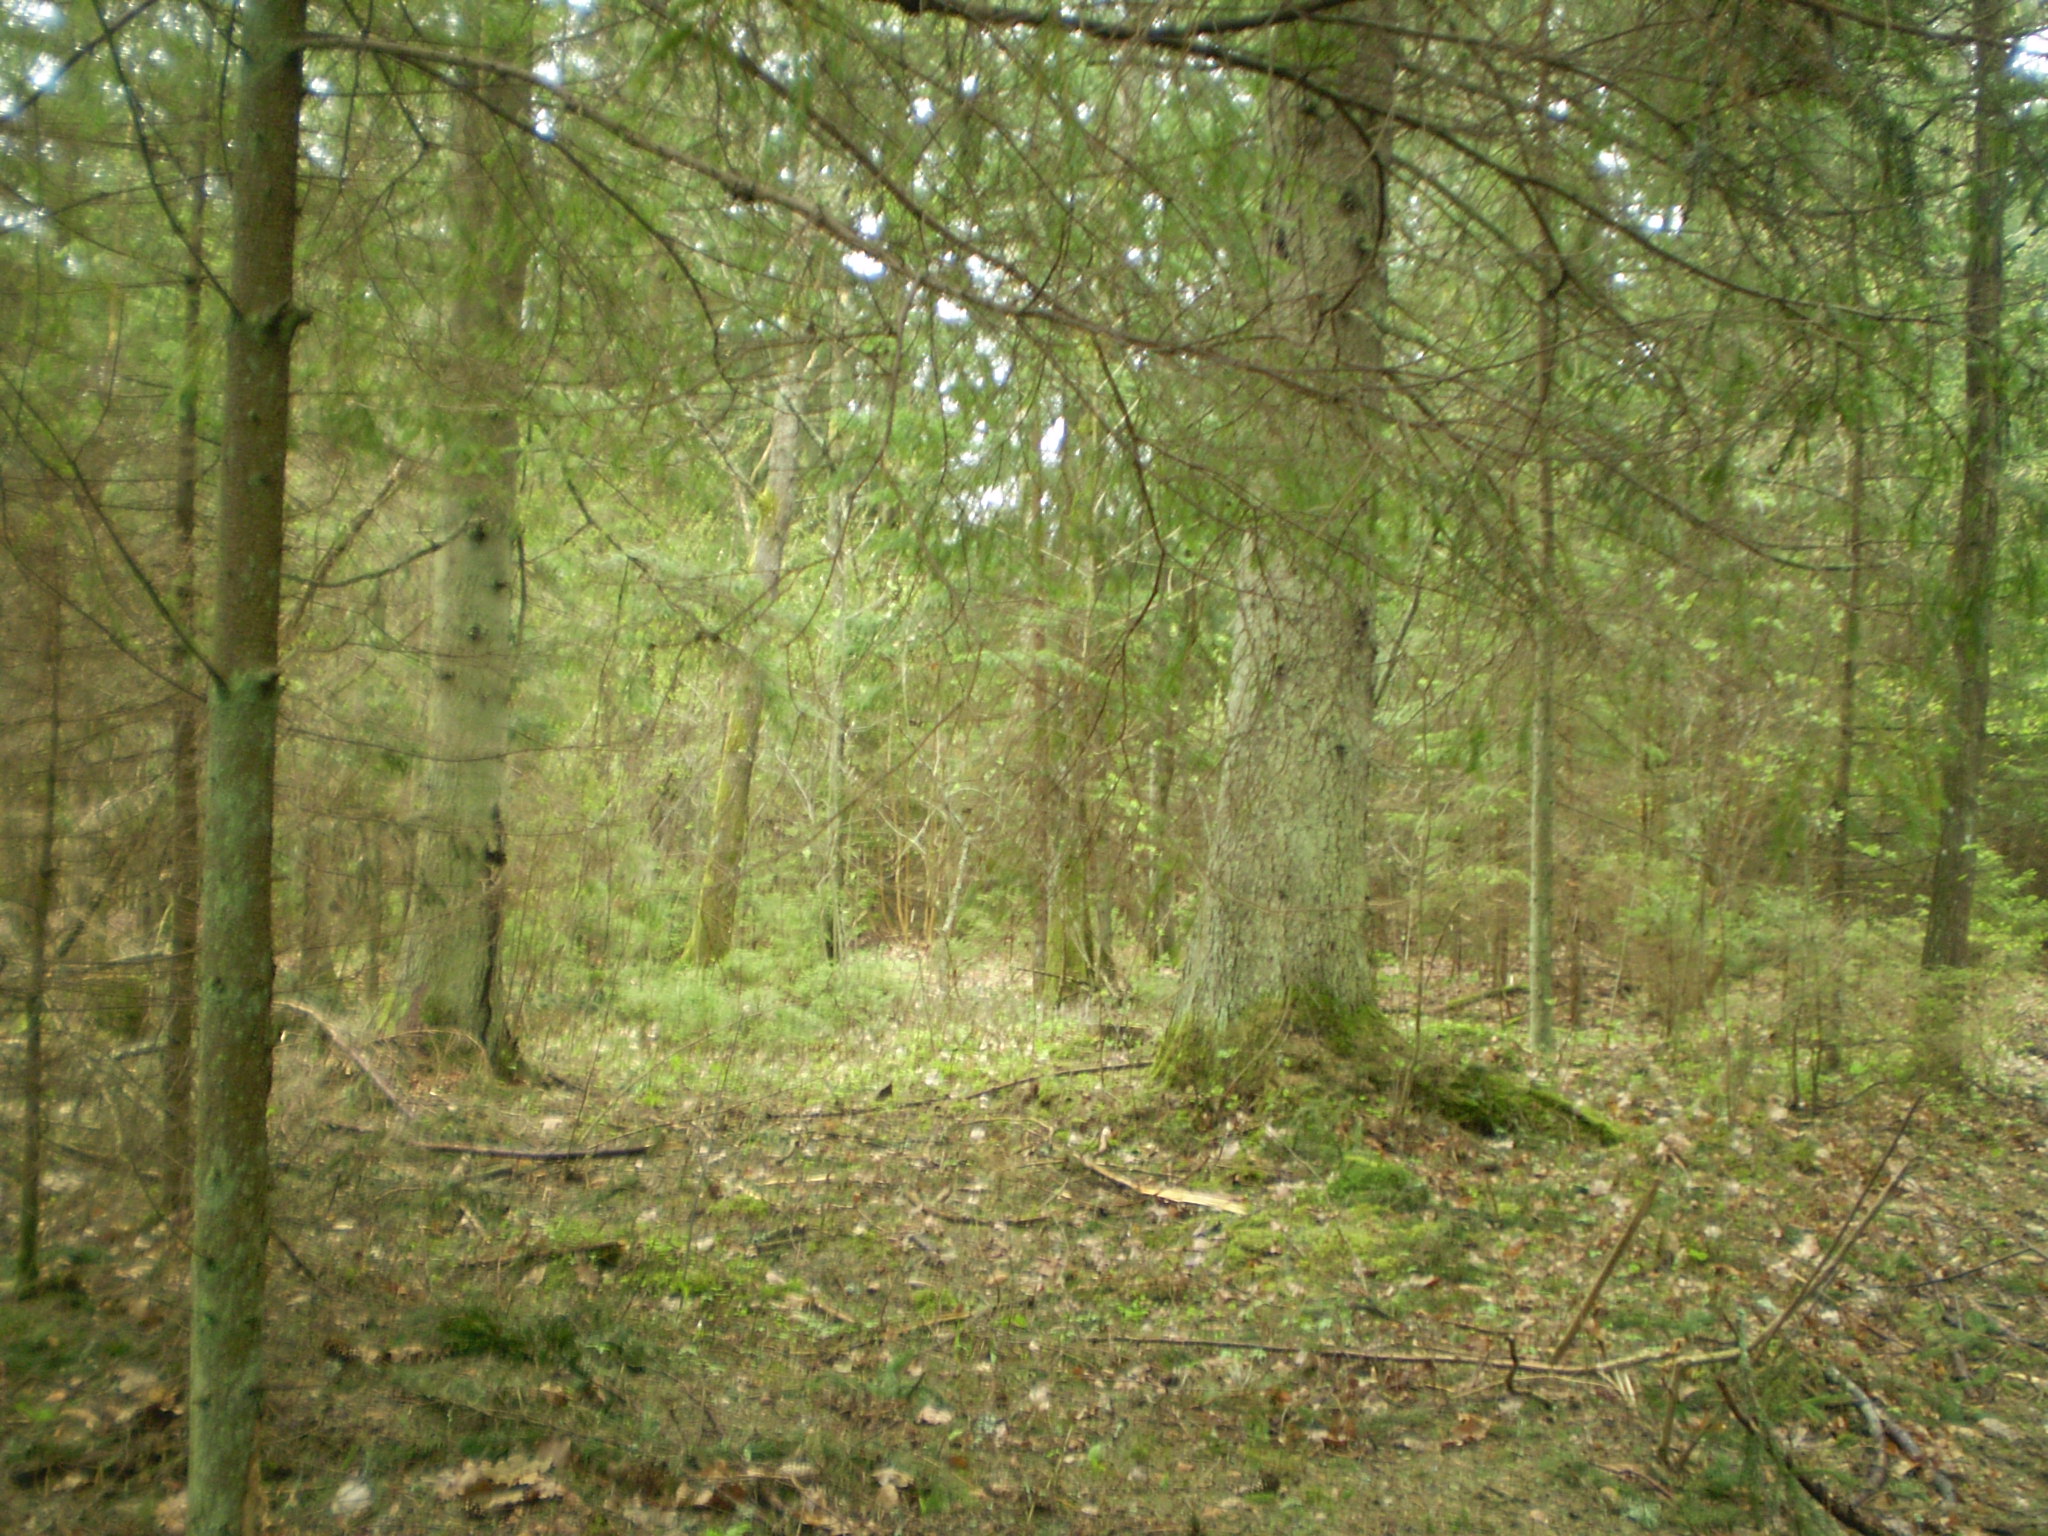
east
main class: Woodland
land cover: Spruce dominated coniferous woodland
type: hemiboreal forest and nemoral coniferous forest and mixed broadleaved-coniferous forest
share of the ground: > 75 %
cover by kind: coniferous forest trees 85 %, broadleaved forest trees 15 %
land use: Forestry
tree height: > 5 m
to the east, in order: Spruce dominated coniferous woodland; Spruce dominated mixed woodland; Tracks; Spruce dominated mixed woodland
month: May
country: LT
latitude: 56.2874
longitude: 22.0870
